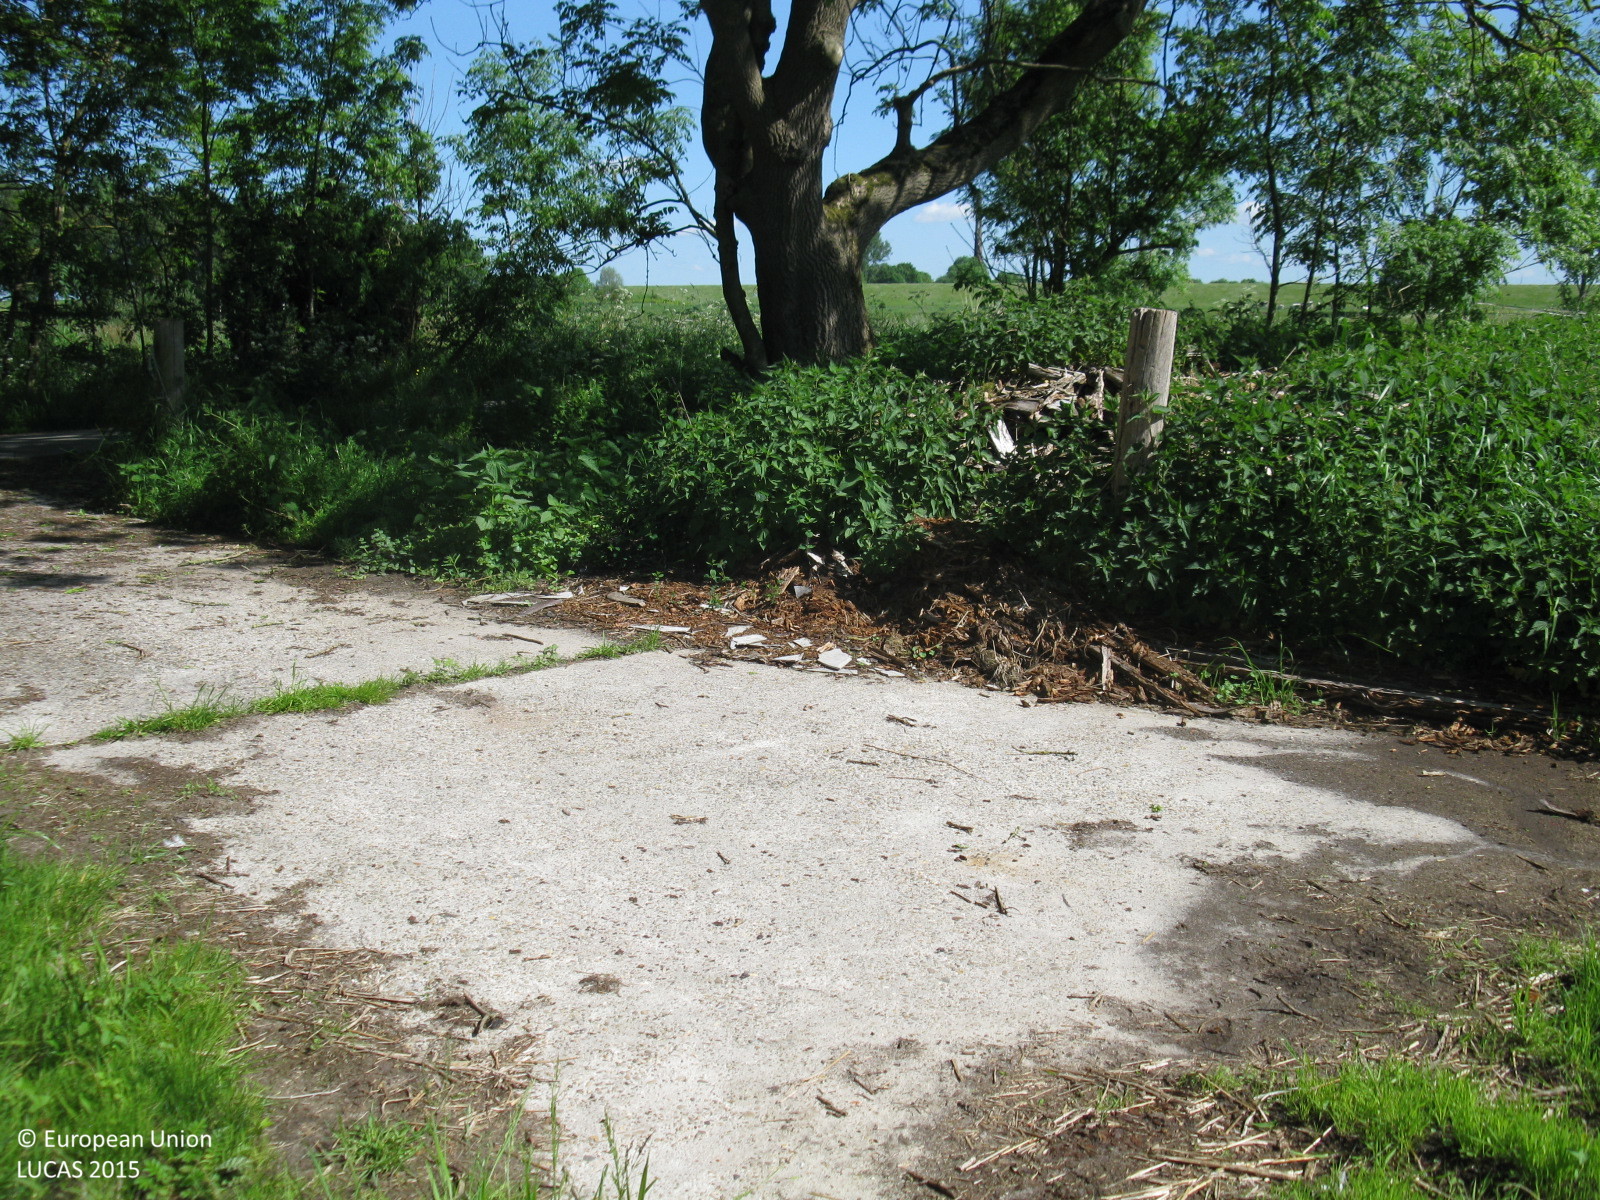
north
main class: Grassland
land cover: Grassland without tree/shrub cover
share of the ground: > 75 %
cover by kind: herbaceous plants 100 %
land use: Residential
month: June
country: DE
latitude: 53.2836
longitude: 7.3757
